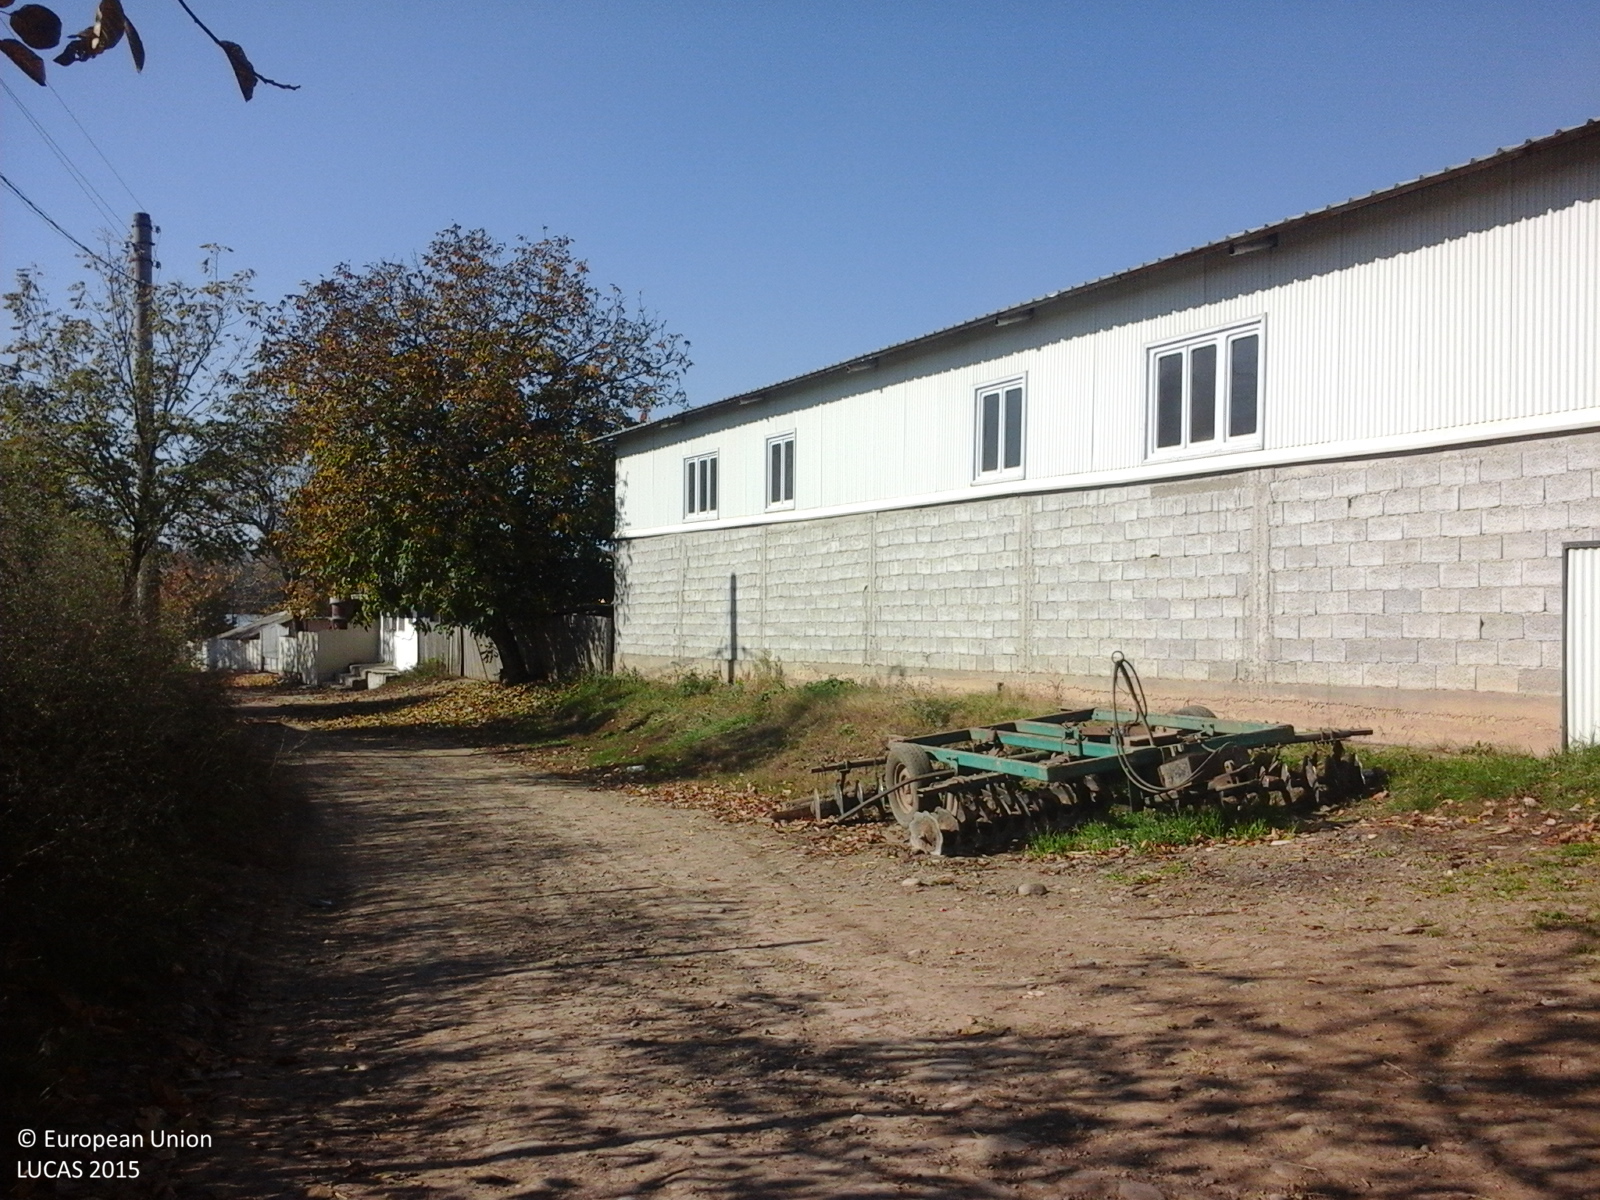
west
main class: Grassland
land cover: Spontaneously vegetated surfaces
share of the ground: > 75 %
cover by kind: herbaceous plants 100 %
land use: Fallow land
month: October
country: RO
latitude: 45.9524
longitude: 27.1118
